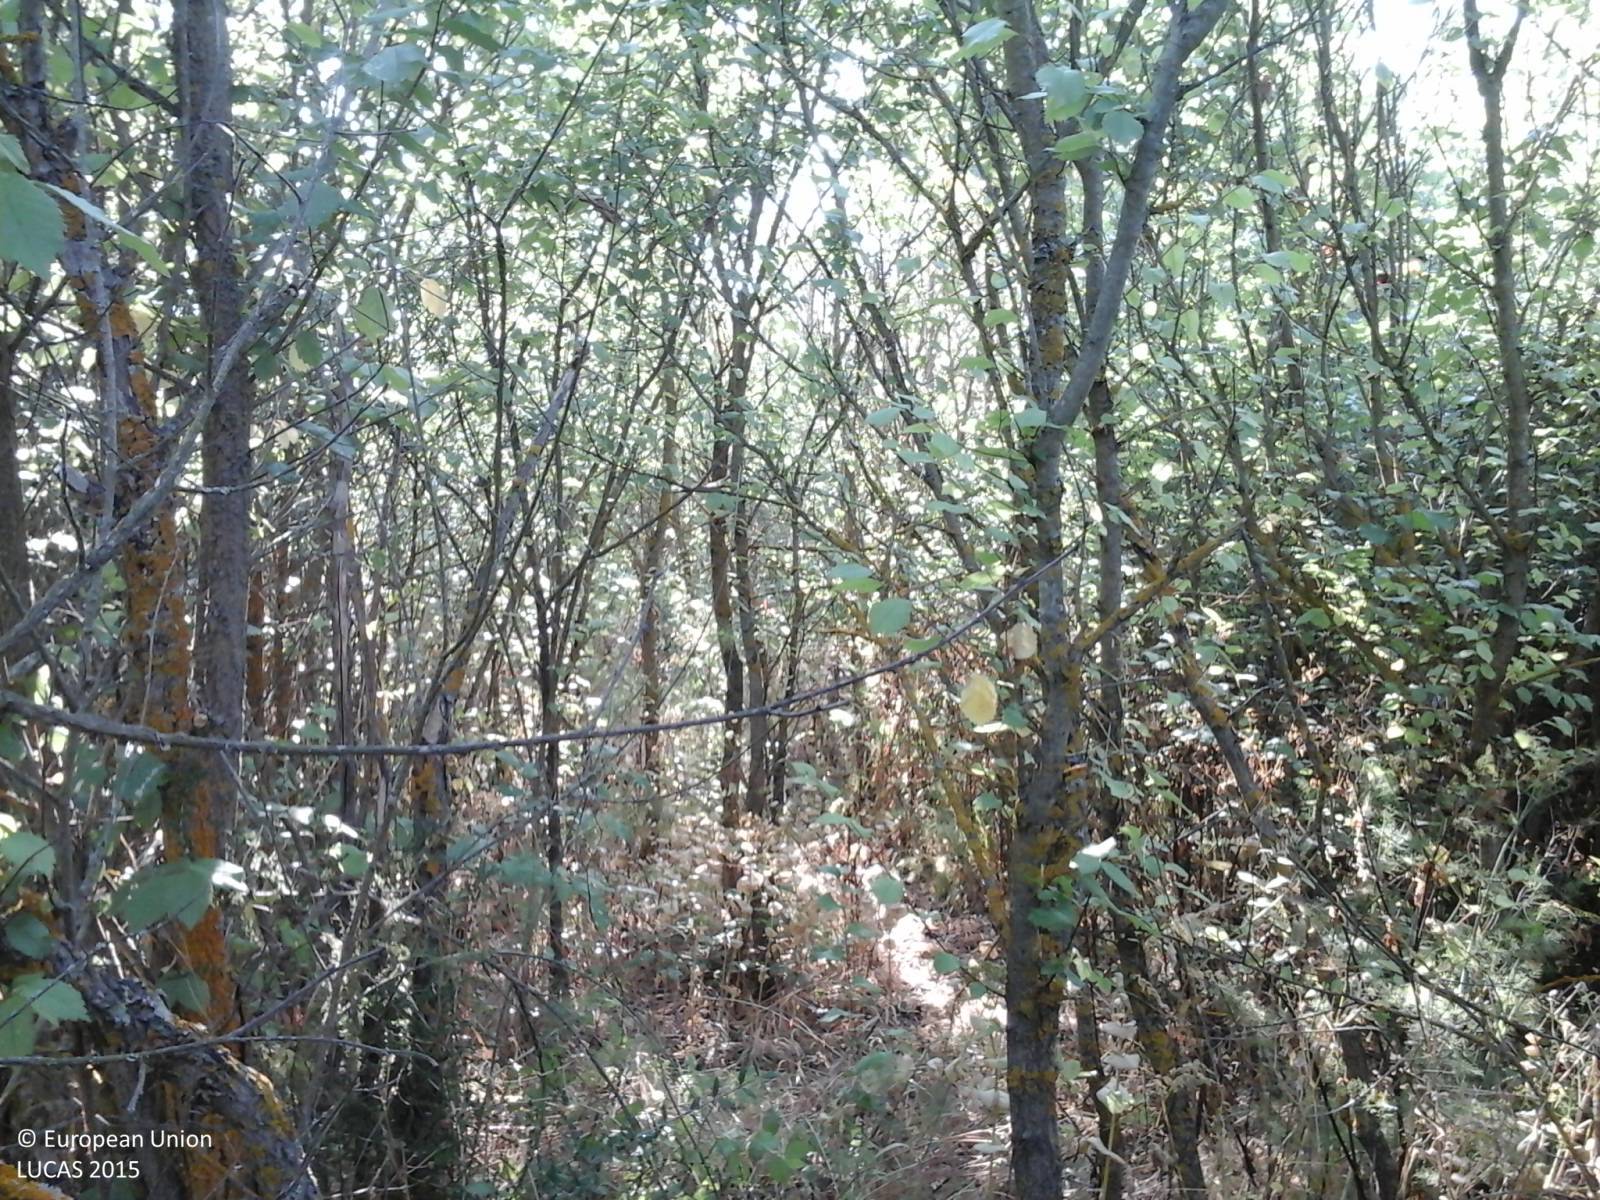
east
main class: Shrubland
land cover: Shrubland with sparse tree cover
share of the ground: > 75 %
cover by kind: shrubs 45 %, herbaceous plants 45 %, broadleaved forest trees 5 %
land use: Semi-natural and natural areas not in use
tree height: < 5 m
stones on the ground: < 10 %
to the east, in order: Shrubland with sparse tree cover; Dry stone walls; Railways; Dry stone walls; Managed hedges; Dry stone walls; Grassland with sparse tree/shrub cover; Dry stone walls; Grassland with sparse tree/shrub cover
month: June
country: IT
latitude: 40.6746
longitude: 8.6696
